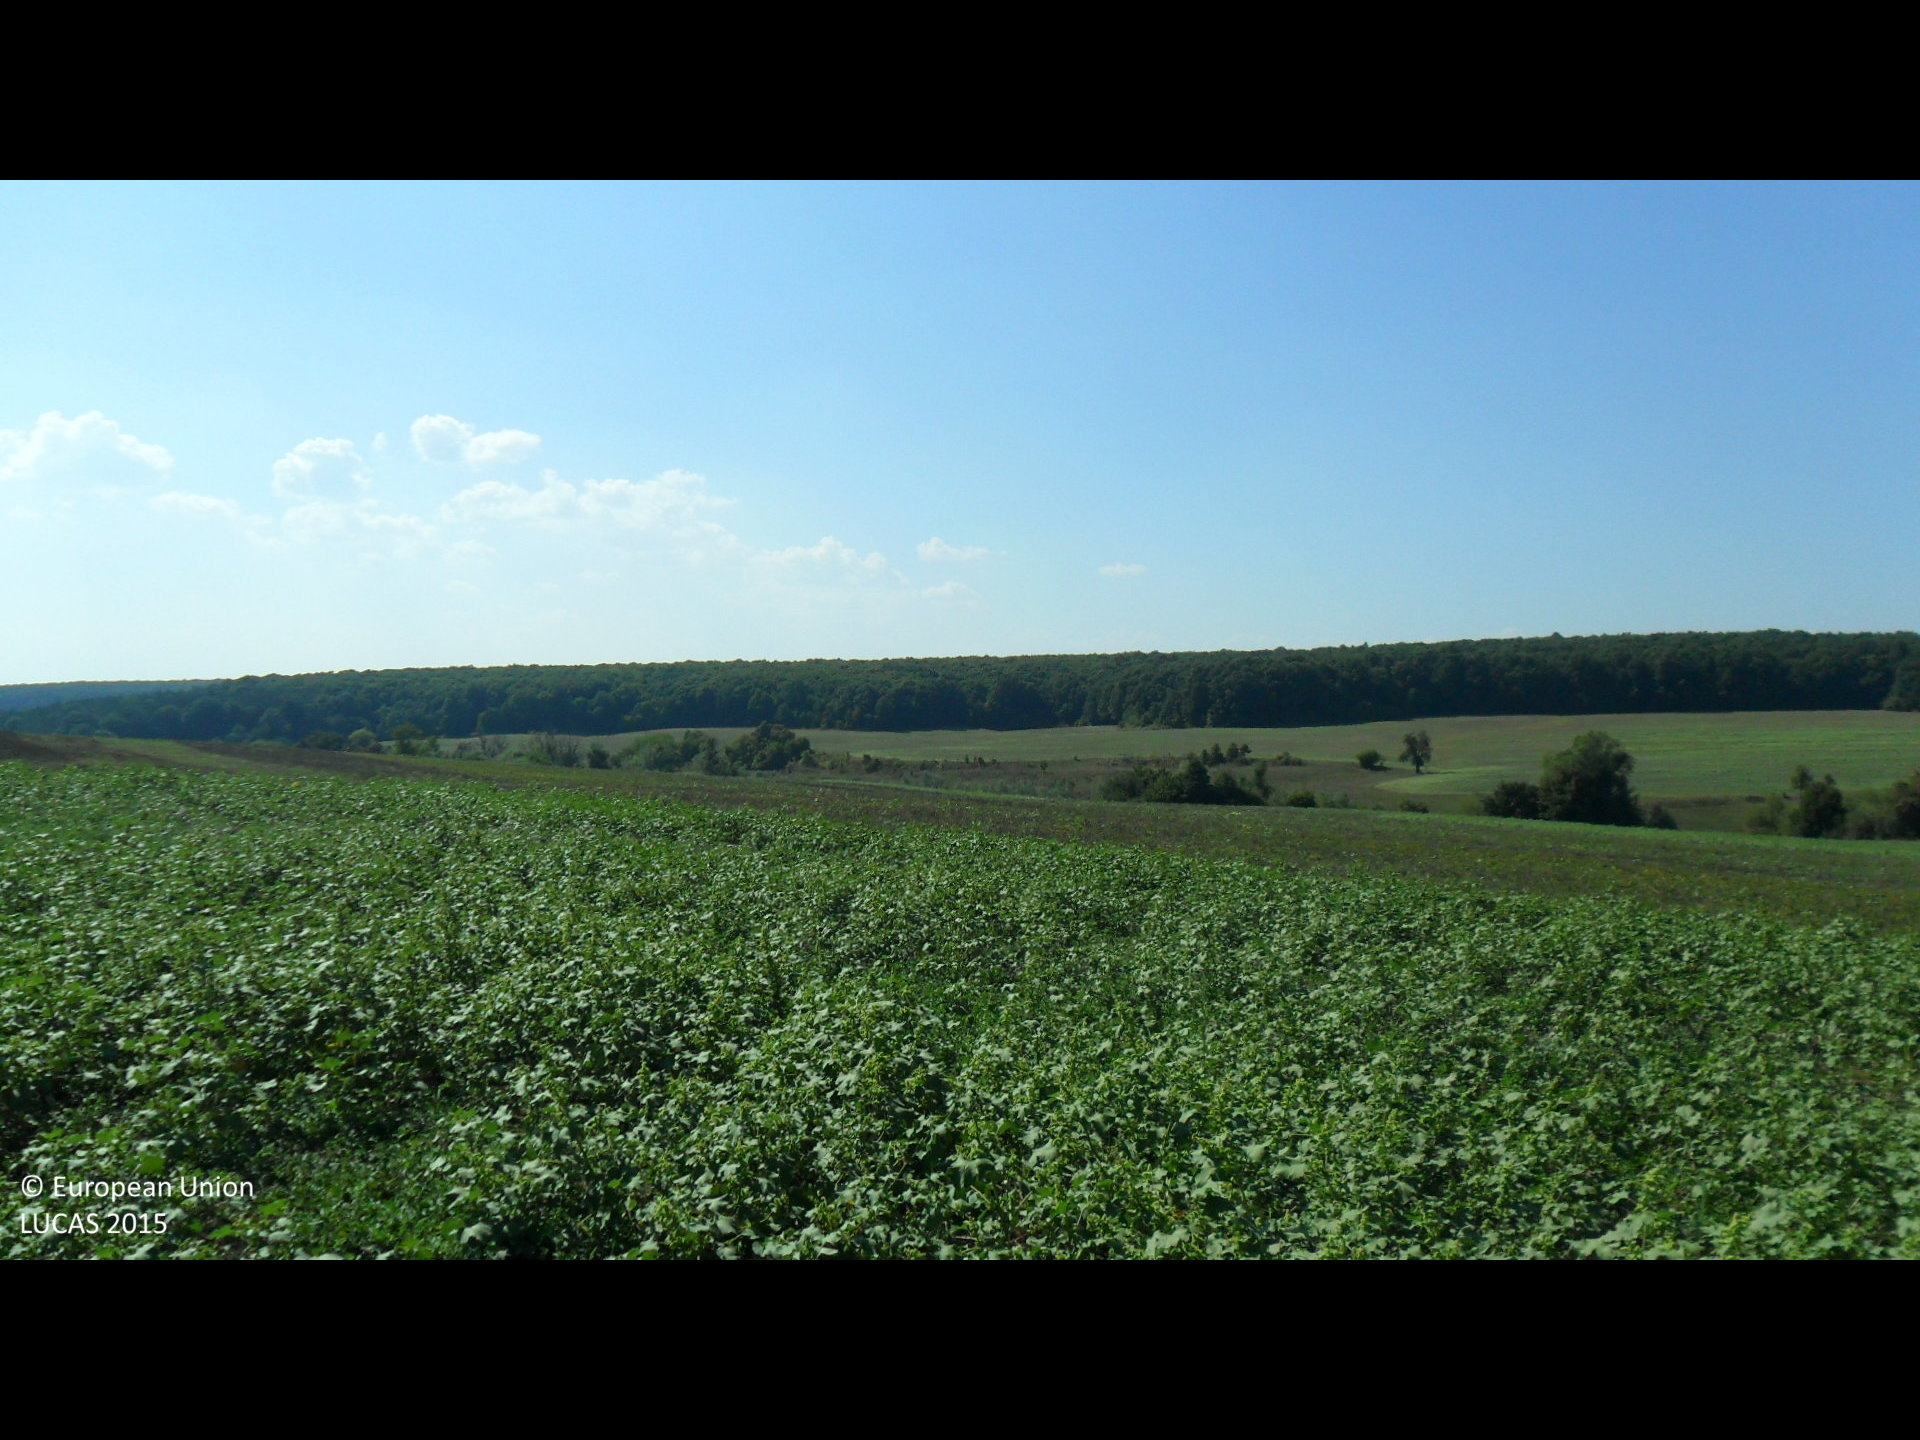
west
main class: Grassland
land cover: Spontaneously vegetated surfaces
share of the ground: > 75 %
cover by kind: herbaceous plants 100 %
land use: Fallow land
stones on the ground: < 10 %
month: August
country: BG
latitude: 43.2307
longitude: 26.4392
